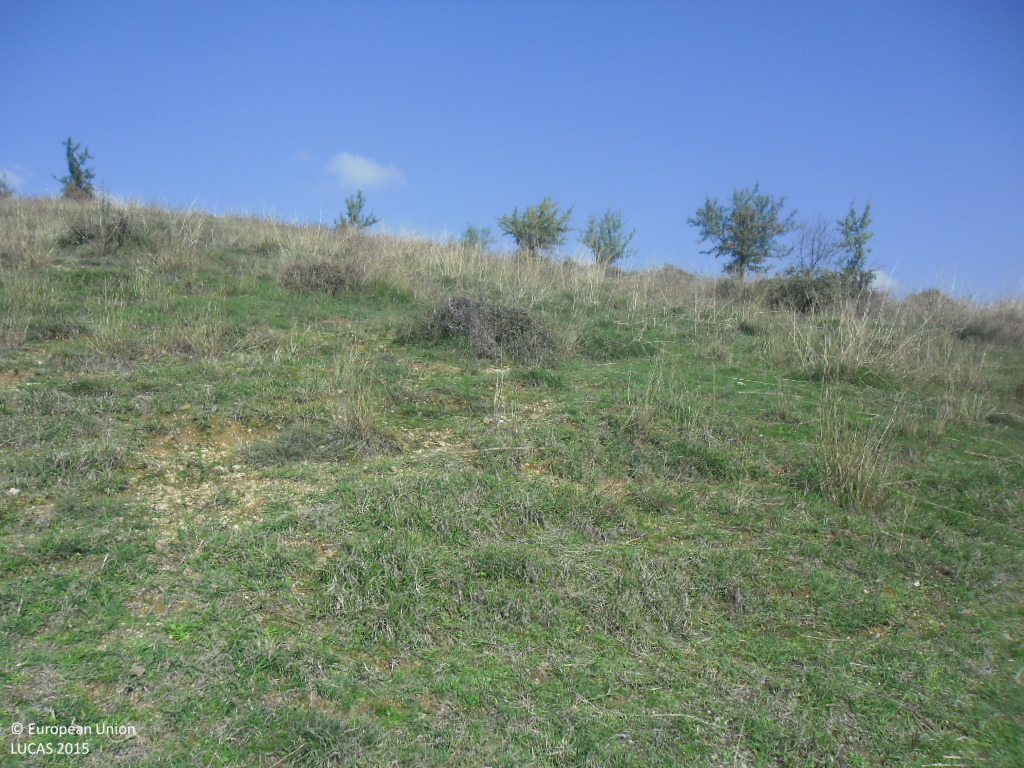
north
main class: Grassland
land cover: Grassland without tree/shrub cover
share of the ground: > 75 %
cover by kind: herbaceous plants 100 %
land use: Agriculture (excluding fallow land and kitchen gardens)
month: October
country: BG
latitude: 41.4600
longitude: 23.1767
